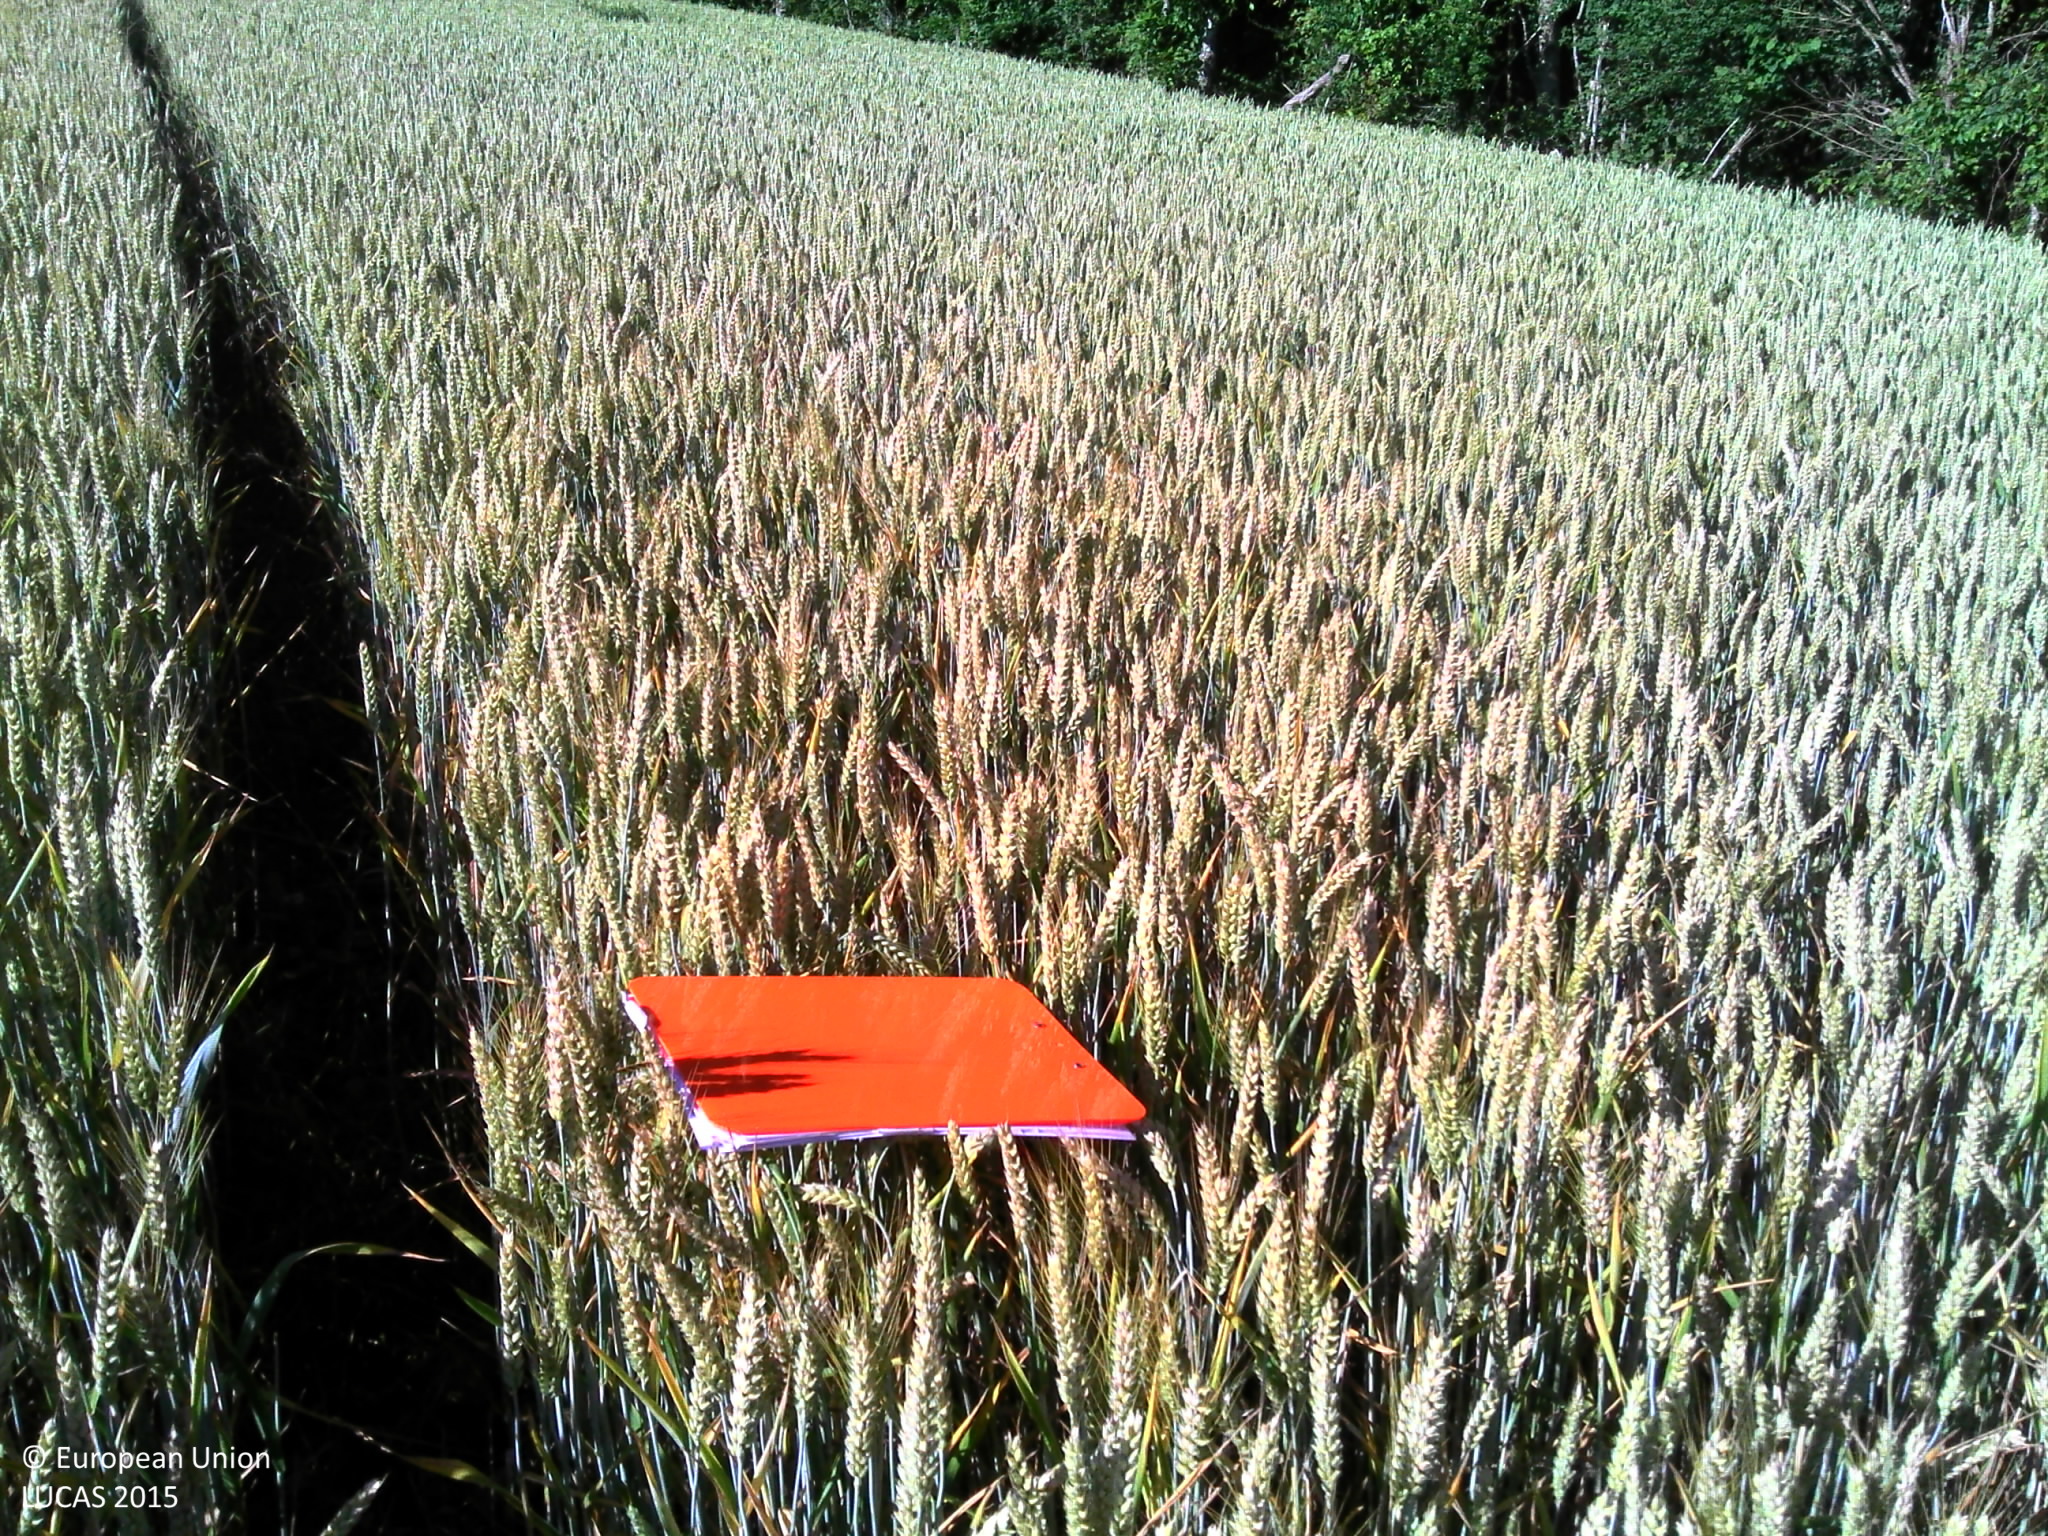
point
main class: Cropland
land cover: Common wheat
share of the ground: > 75 %
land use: Agriculture (excluding fallow land and kitchen gardens)
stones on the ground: 10 - 25 %
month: June
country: FR
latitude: 47.3992
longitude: 3.4907
